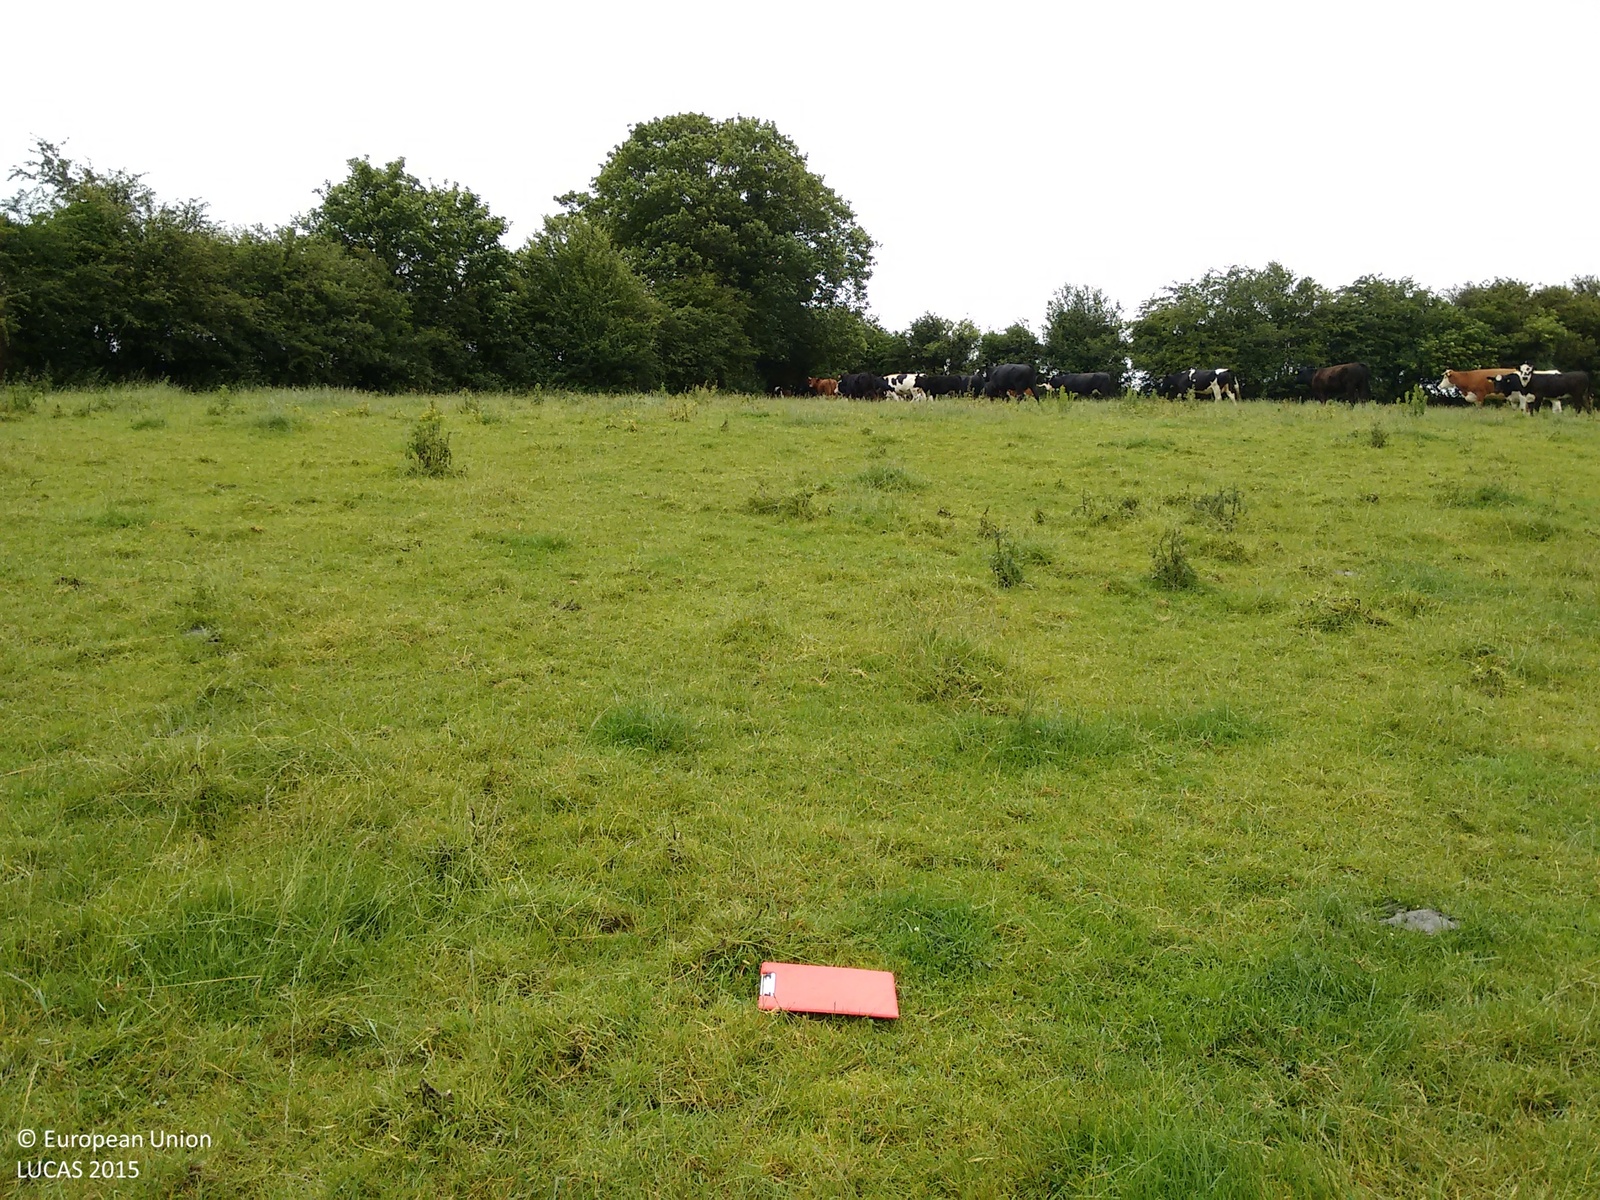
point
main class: Grassland
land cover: Grassland without tree/shrub cover
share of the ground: > 75 %
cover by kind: herbaceous plants 100 %
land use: Agriculture (excluding fallow land and kitchen gardens)
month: July
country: IE
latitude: 53.5024
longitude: -7.8233
